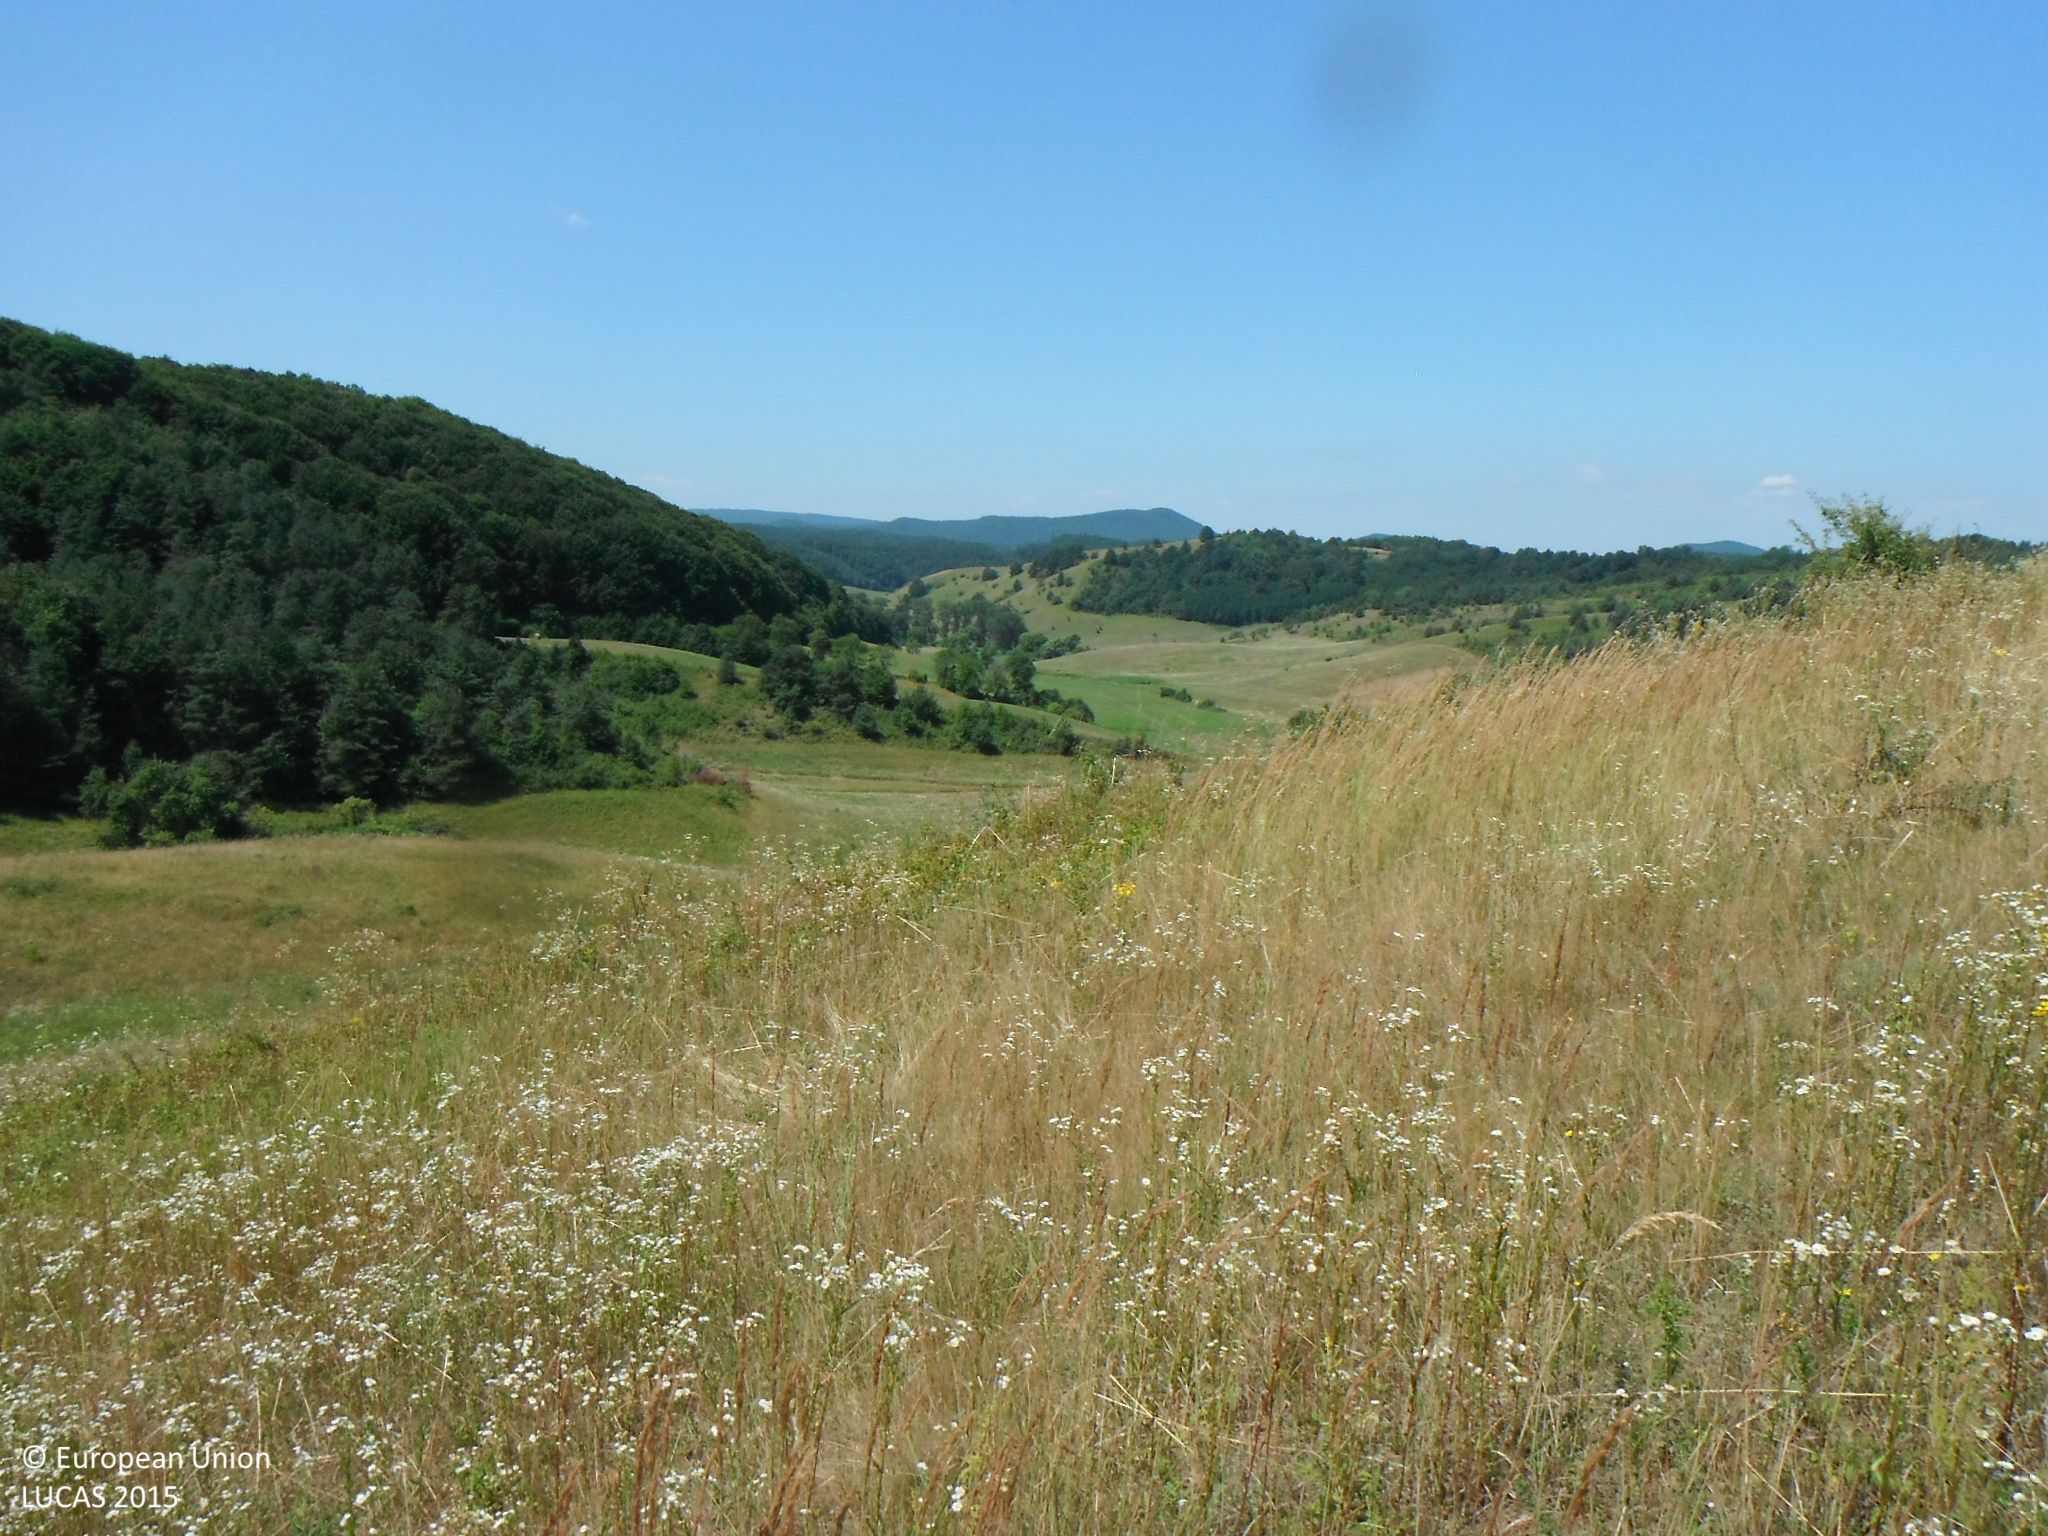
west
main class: Grassland
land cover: Spontaneously vegetated surfaces
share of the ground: > 75 %
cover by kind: herbaceous plants 100 %
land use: Fallow land
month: July
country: SK
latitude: 48.2134
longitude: 20.0827
